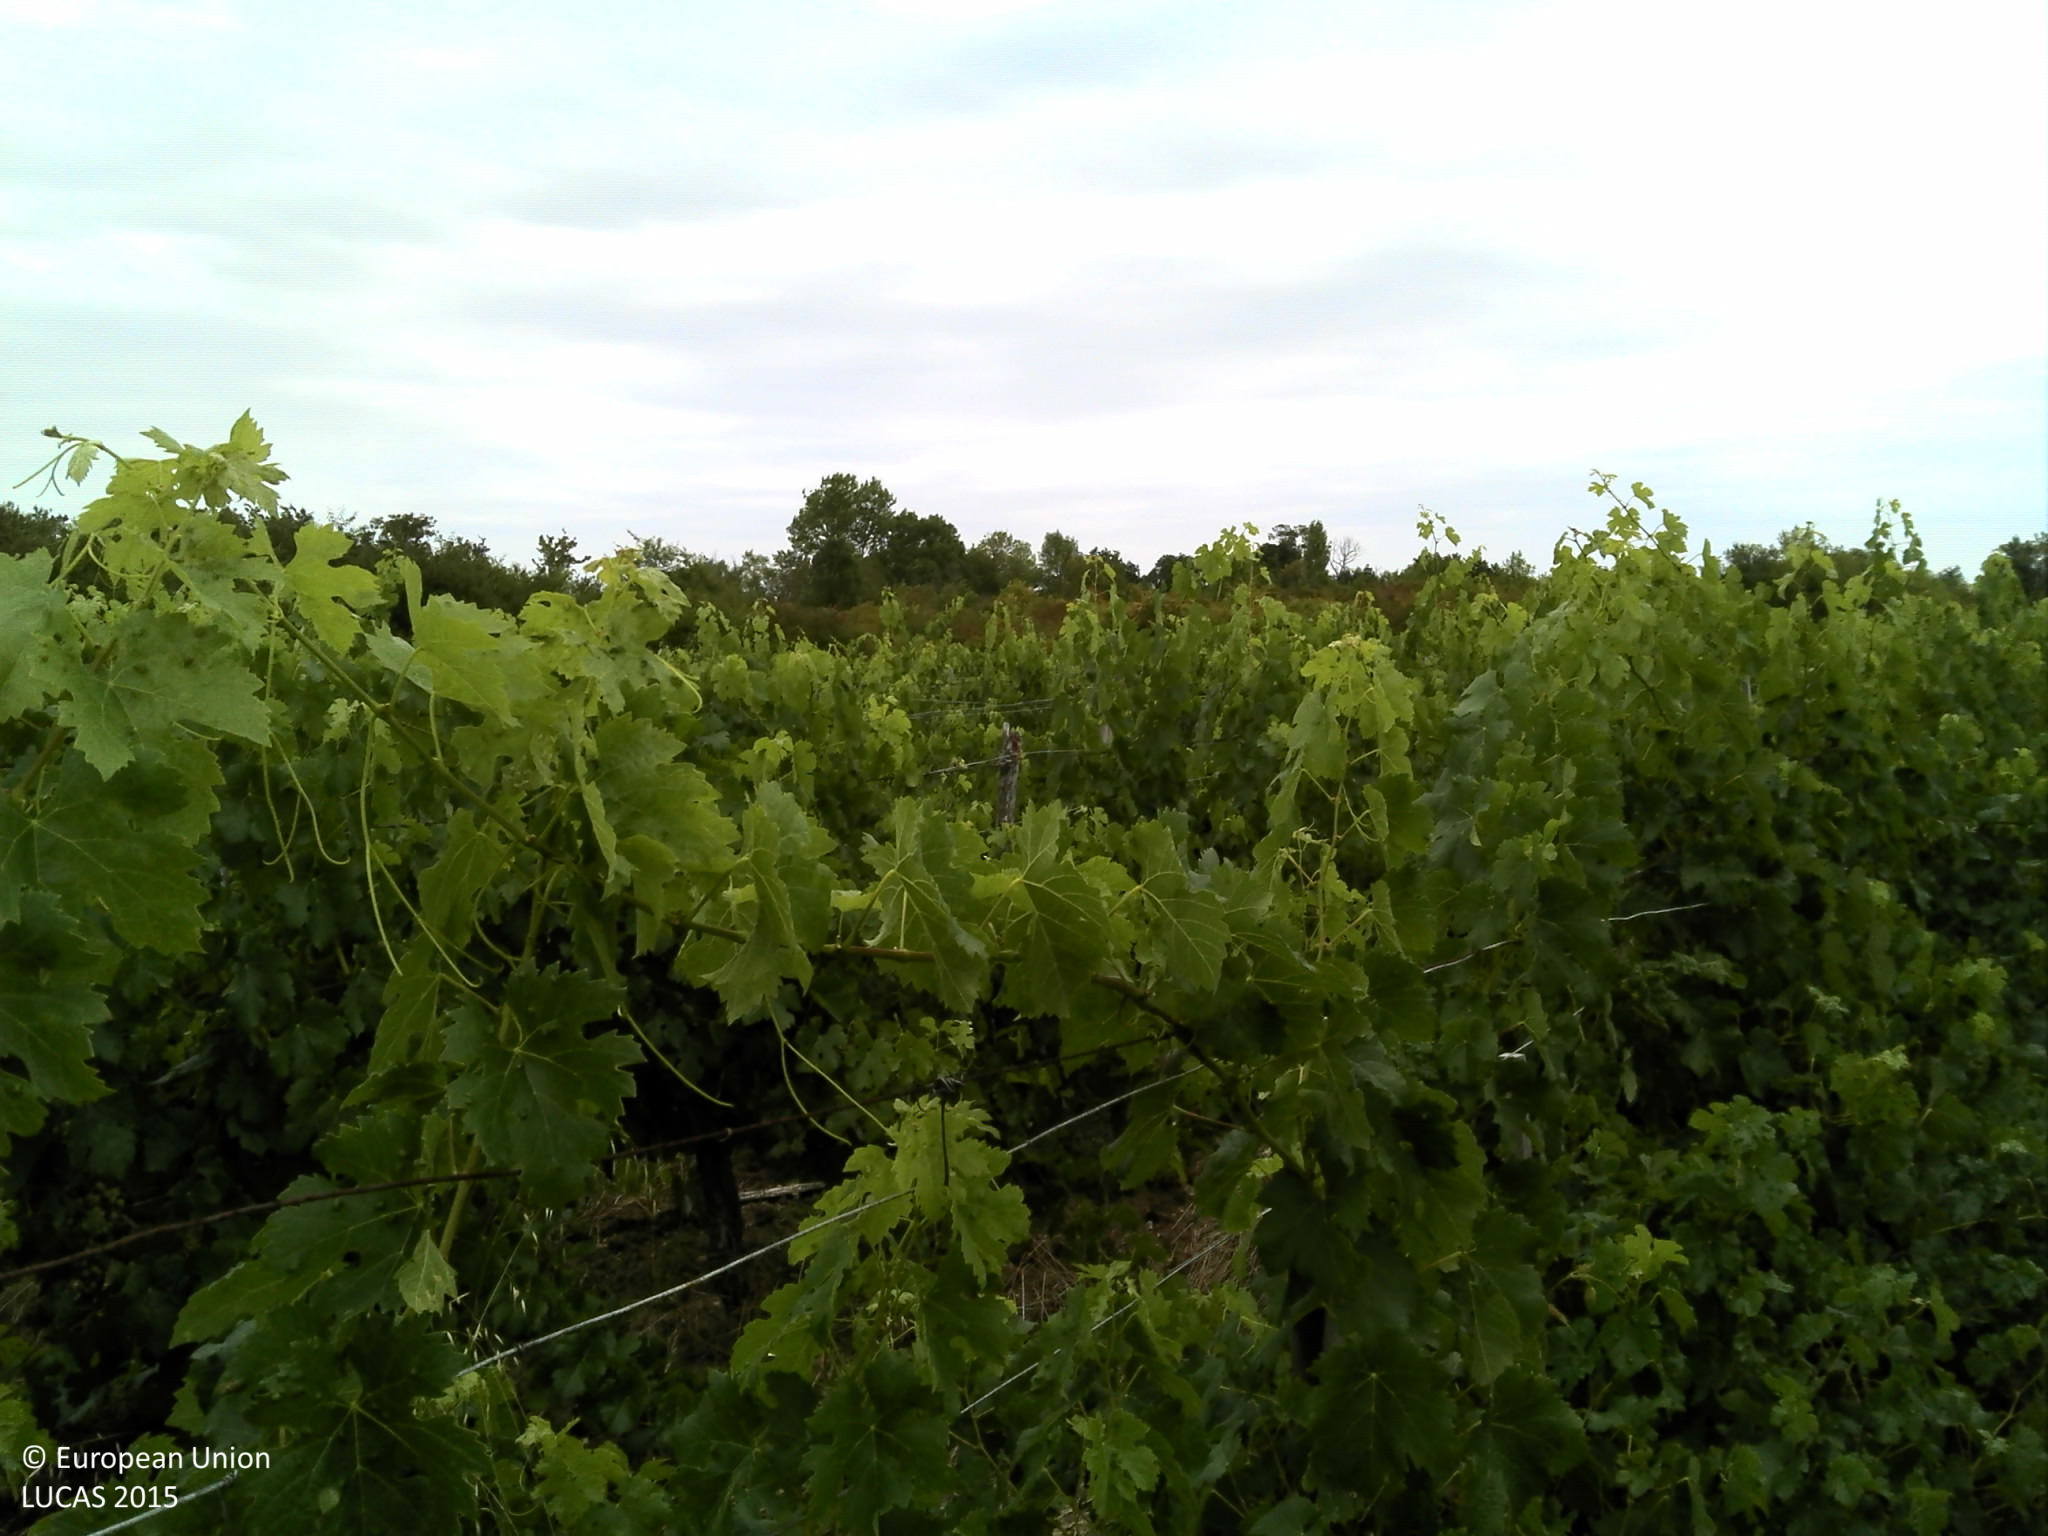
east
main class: Cropland
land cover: Vineyards
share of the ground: 50 - 75 %
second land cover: Grassland without tree/shrub cover
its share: 25 - 50 %
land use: Agriculture (excluding fallow land and kitchen gardens)
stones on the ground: < 10 %
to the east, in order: Vineyards; Grassland without tree/shrub cover; Tracks; Vineyards; Broadleaved woodland; Tracks; Vineyards; Tracks; Broadleaved woodland; Tracks; Fences; Grassland without tree/shrub cover
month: August
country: FR
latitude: 45.1697
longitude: -0.5938
